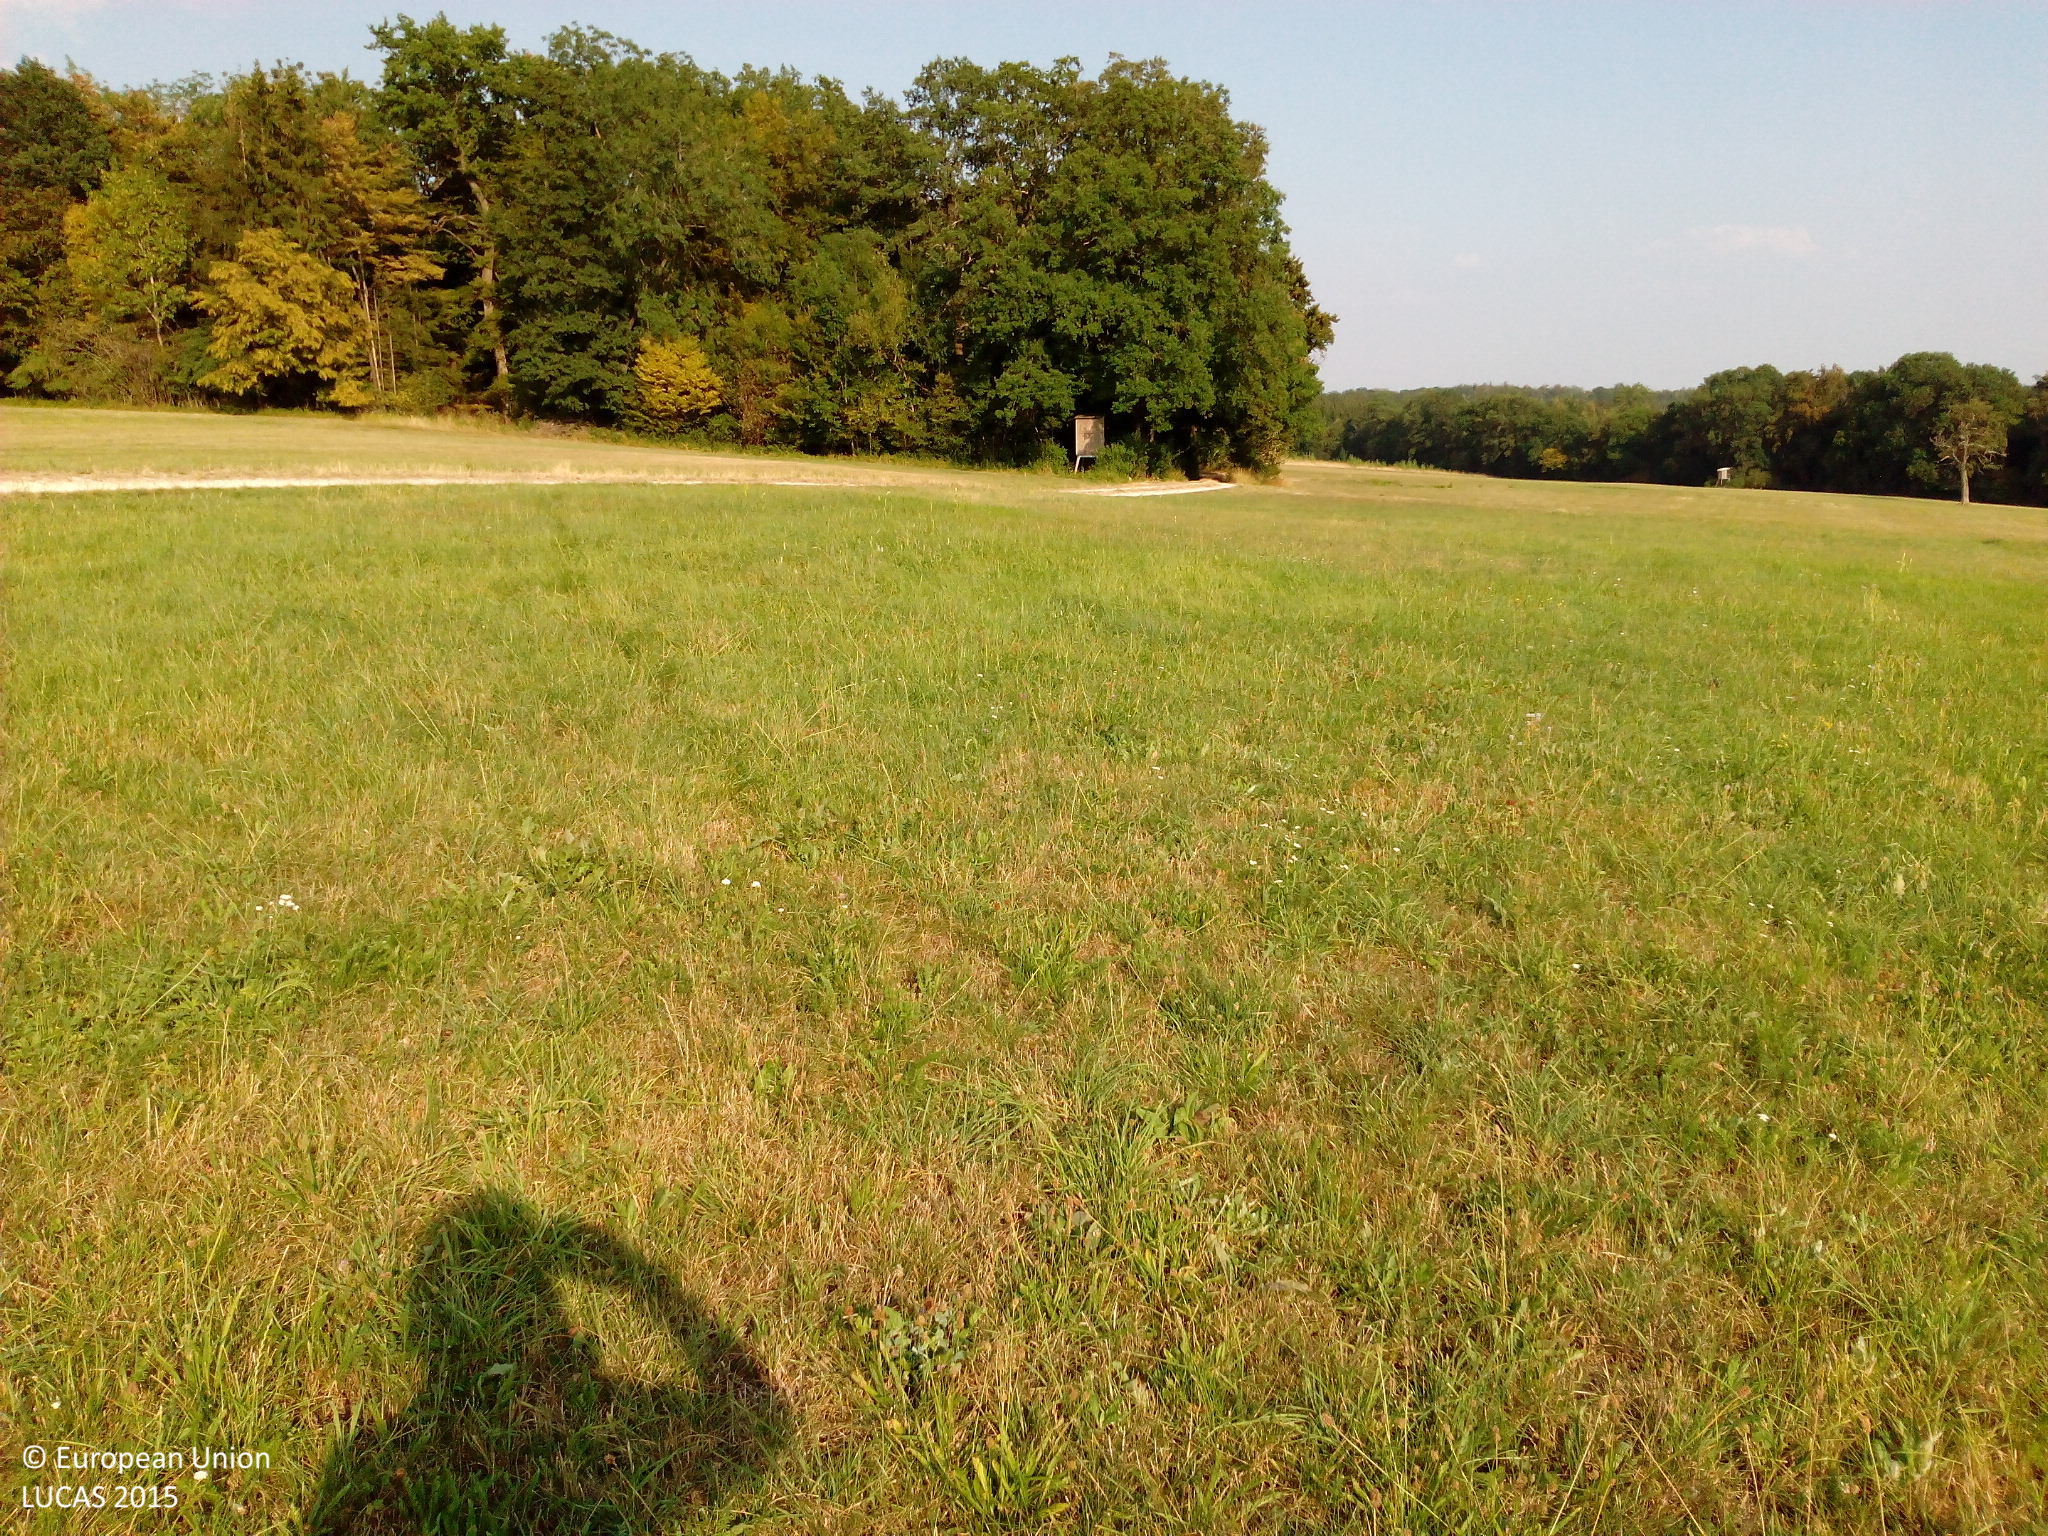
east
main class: Grassland
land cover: Grassland without tree/shrub cover
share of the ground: > 75 %
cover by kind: herbaceous plants 95 %, unconsolidated bare surface 5 %
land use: Agriculture (excluding fallow land and kitchen gardens)
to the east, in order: Grassland without tree/shrub cover; Tracks; Grassland without tree/shrub cover; Broadleaved woodland; Spruce dominated coniferous woodland
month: August
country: DE
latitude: 48.6909
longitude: 10.3123
